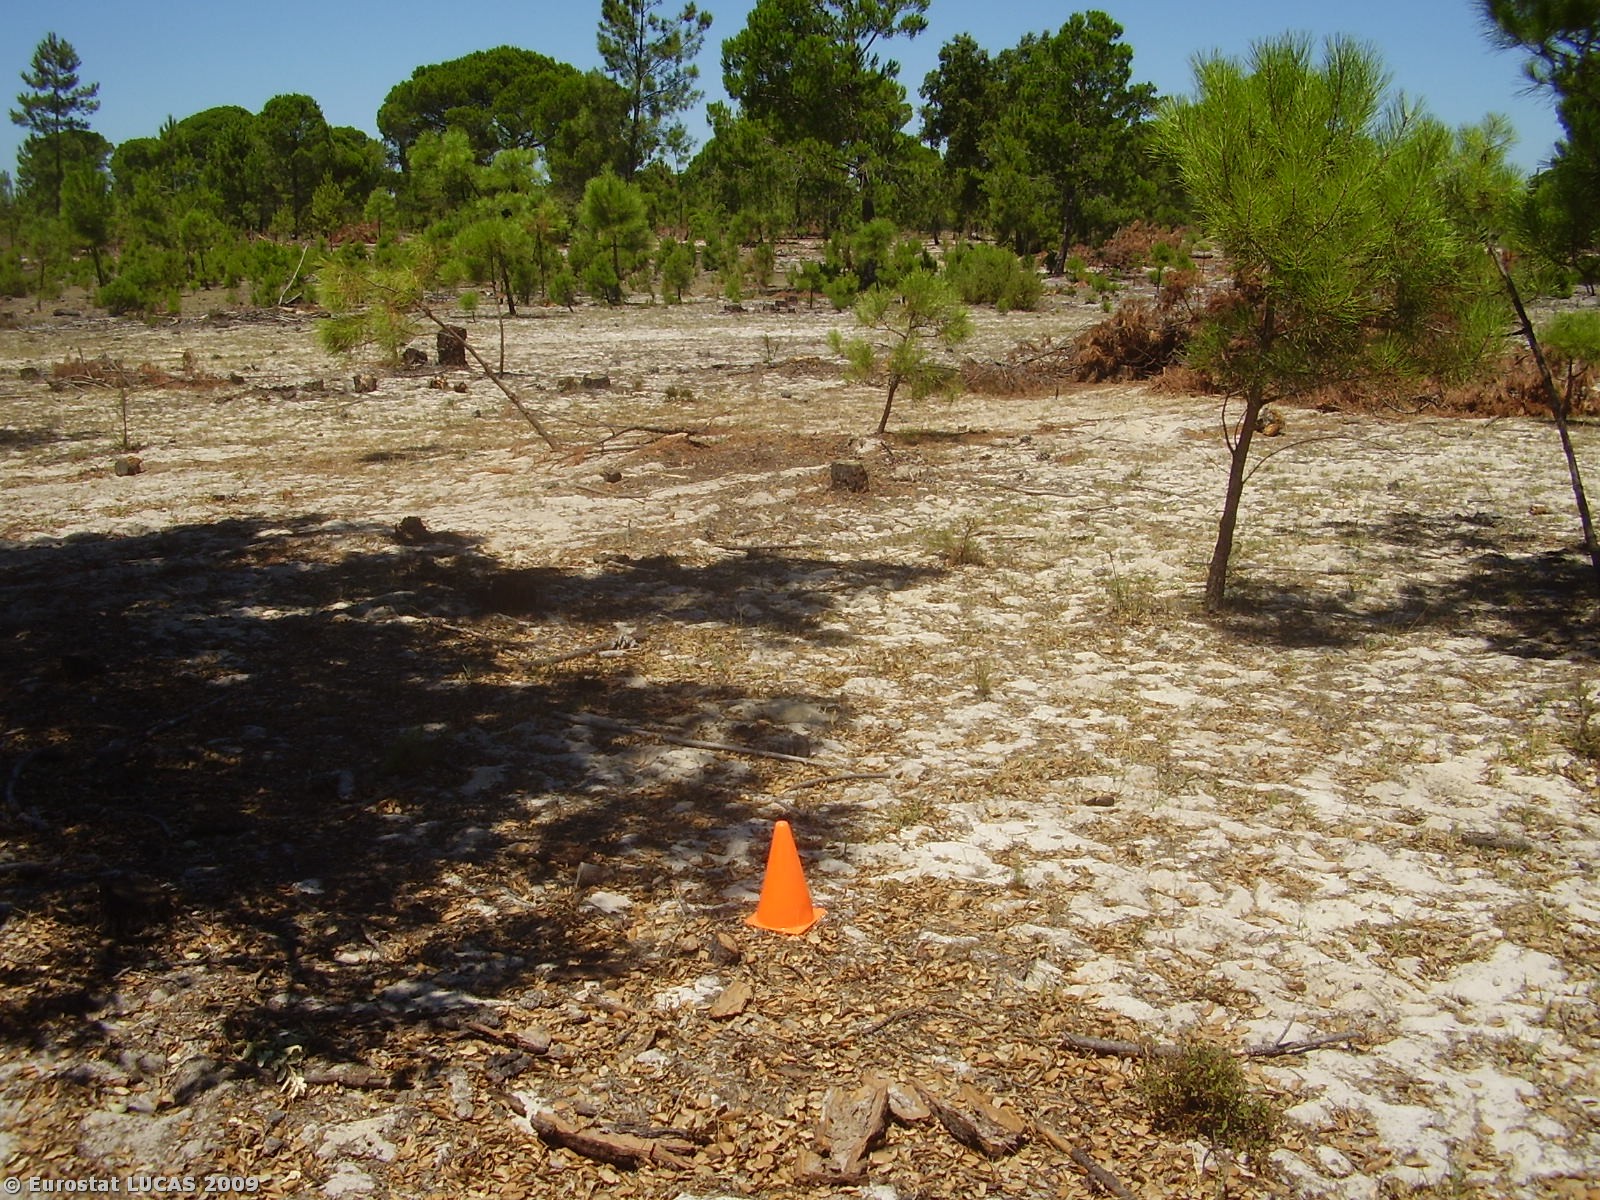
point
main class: Woodland
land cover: Coniferous woodland
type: coniferous forest of the mediterranean region
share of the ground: 10 - 25 %
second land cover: Grassland with sparse tree/shrub cover
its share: 10 - 25 %
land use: Forestry
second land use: Fallow land
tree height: > 5 m
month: July
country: PT
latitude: 38.1922
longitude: -8.4161
